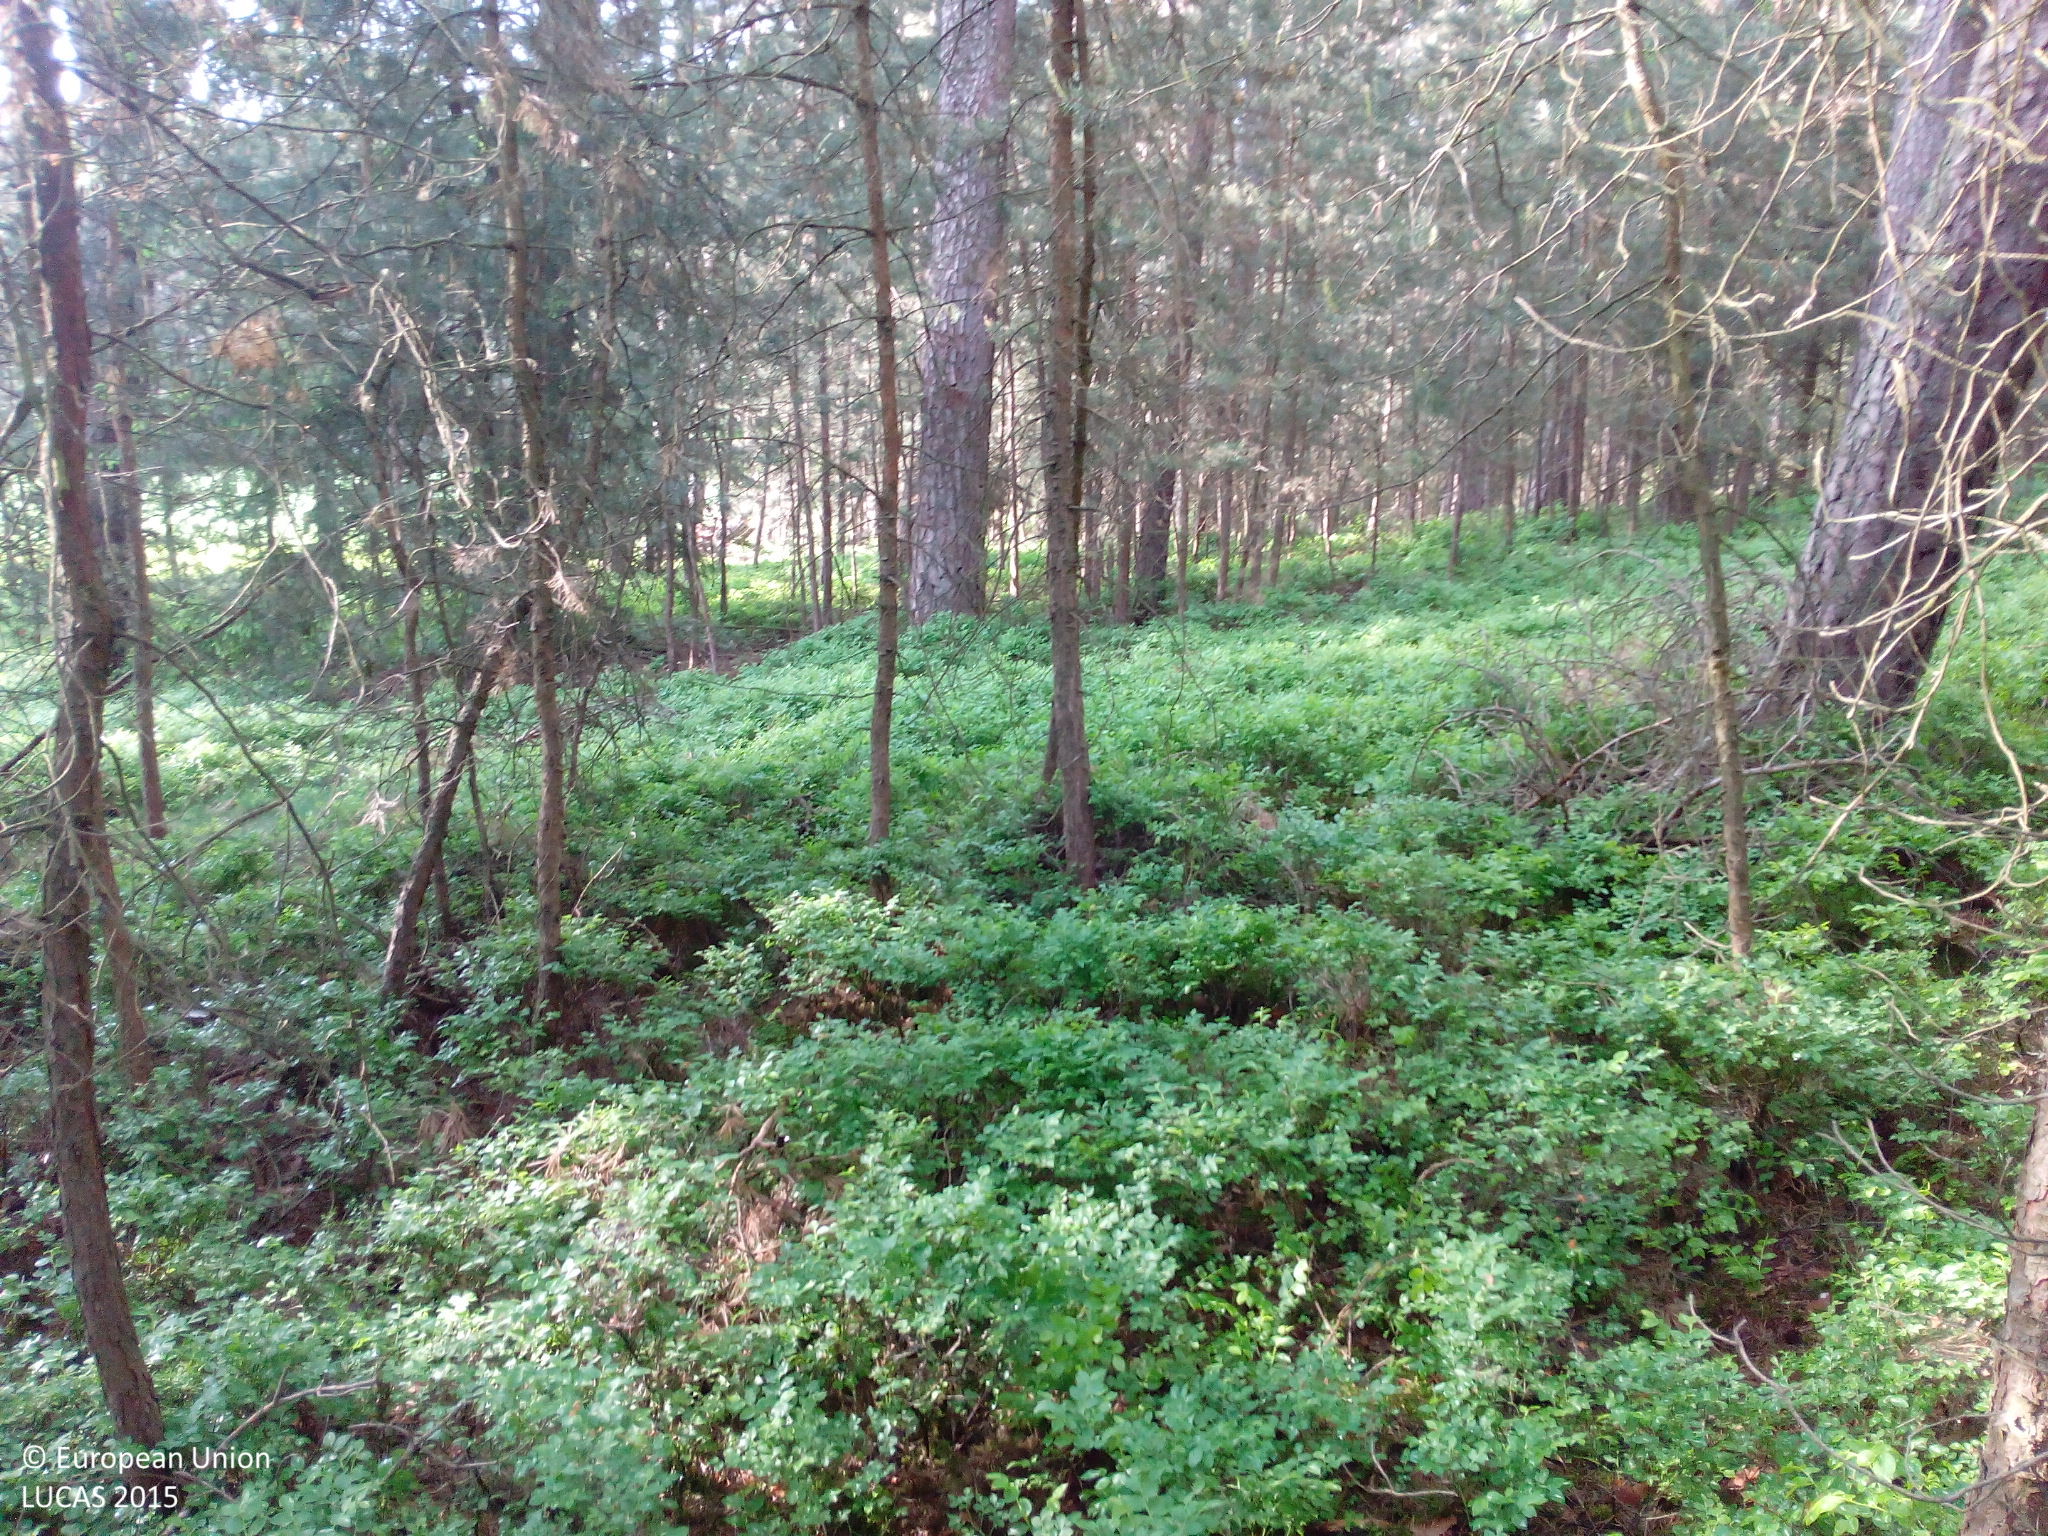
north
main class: Woodland
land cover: Pine dominated coniferous woodland
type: hemiboreal forest and nemoral coniferous forest and mixed broadleaved-coniferous forest
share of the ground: > 75 %
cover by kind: coniferous forest trees 95 %, herbaceous plants 5 %
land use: Forestry
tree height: > 5 m
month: May
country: DE
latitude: 49.1218
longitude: 10.5342
